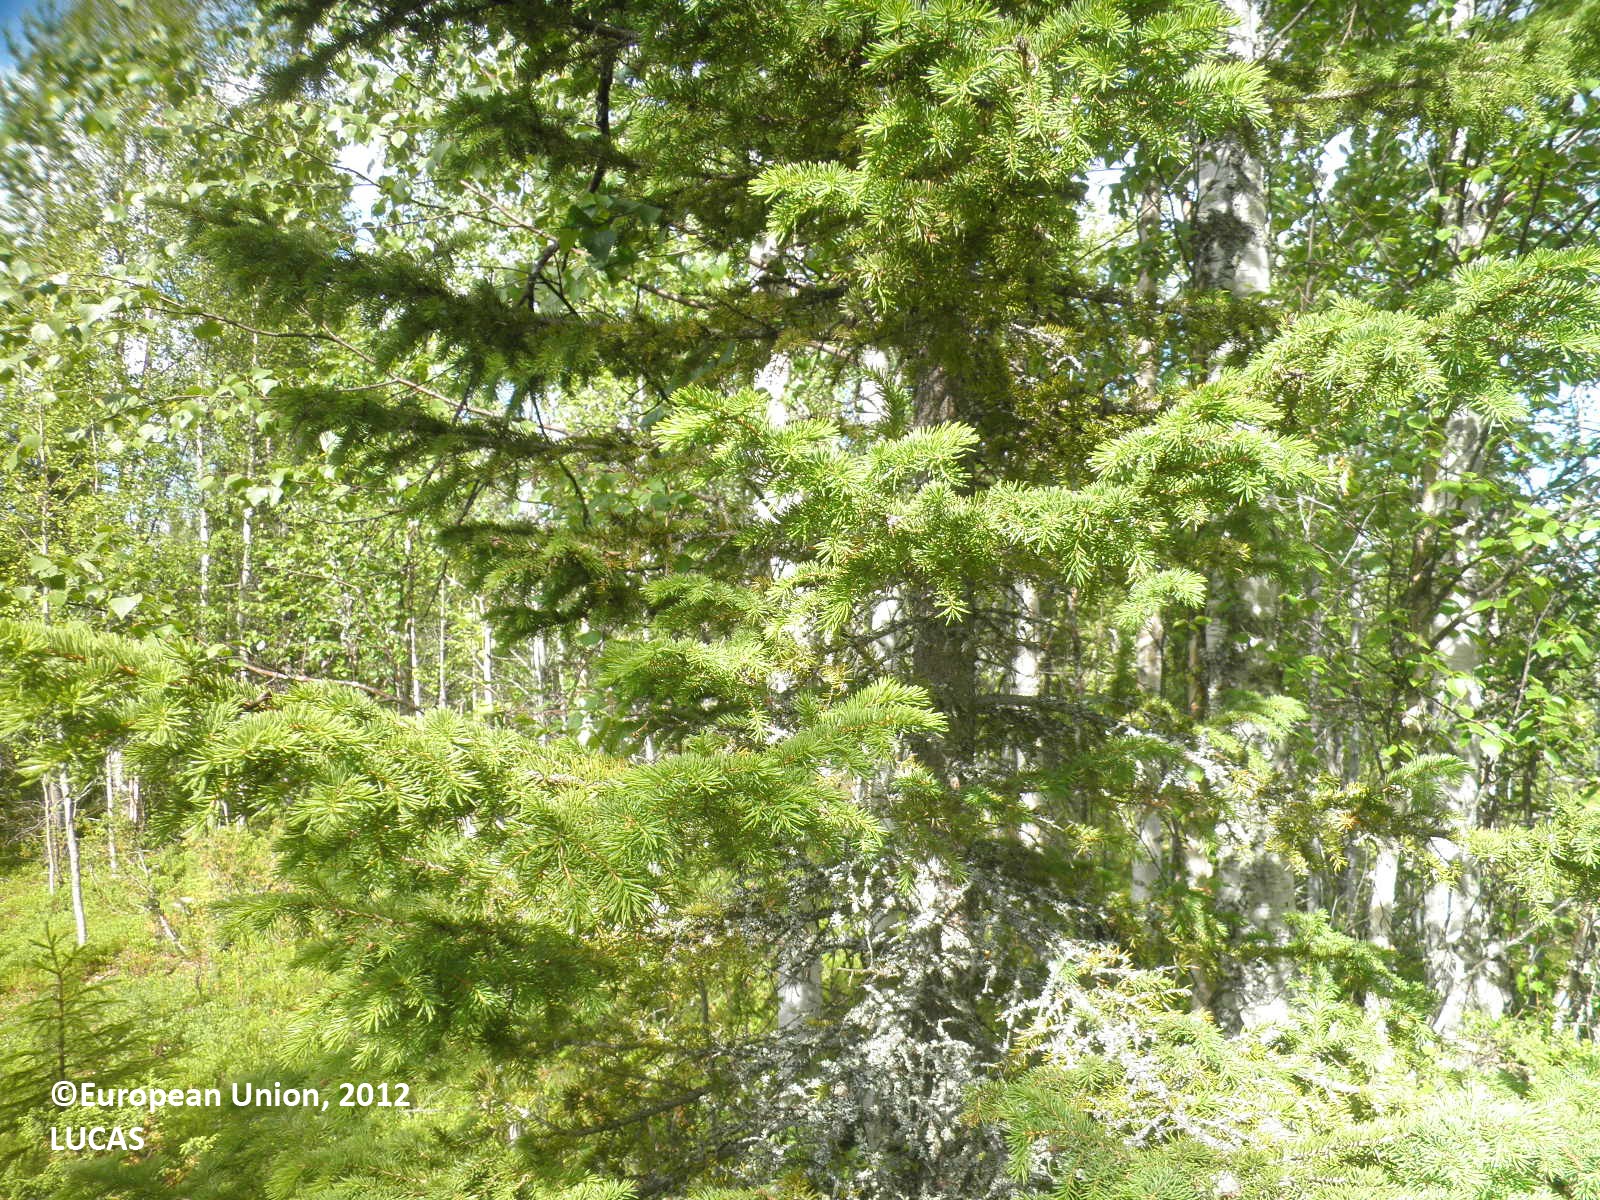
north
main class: Woodland
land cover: Spruce dominated mixed woodland
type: boreal forest
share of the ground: 50 - 75 %
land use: Forestry
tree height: > 5 m
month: July
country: FI
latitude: 67.6541
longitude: 25.8695
